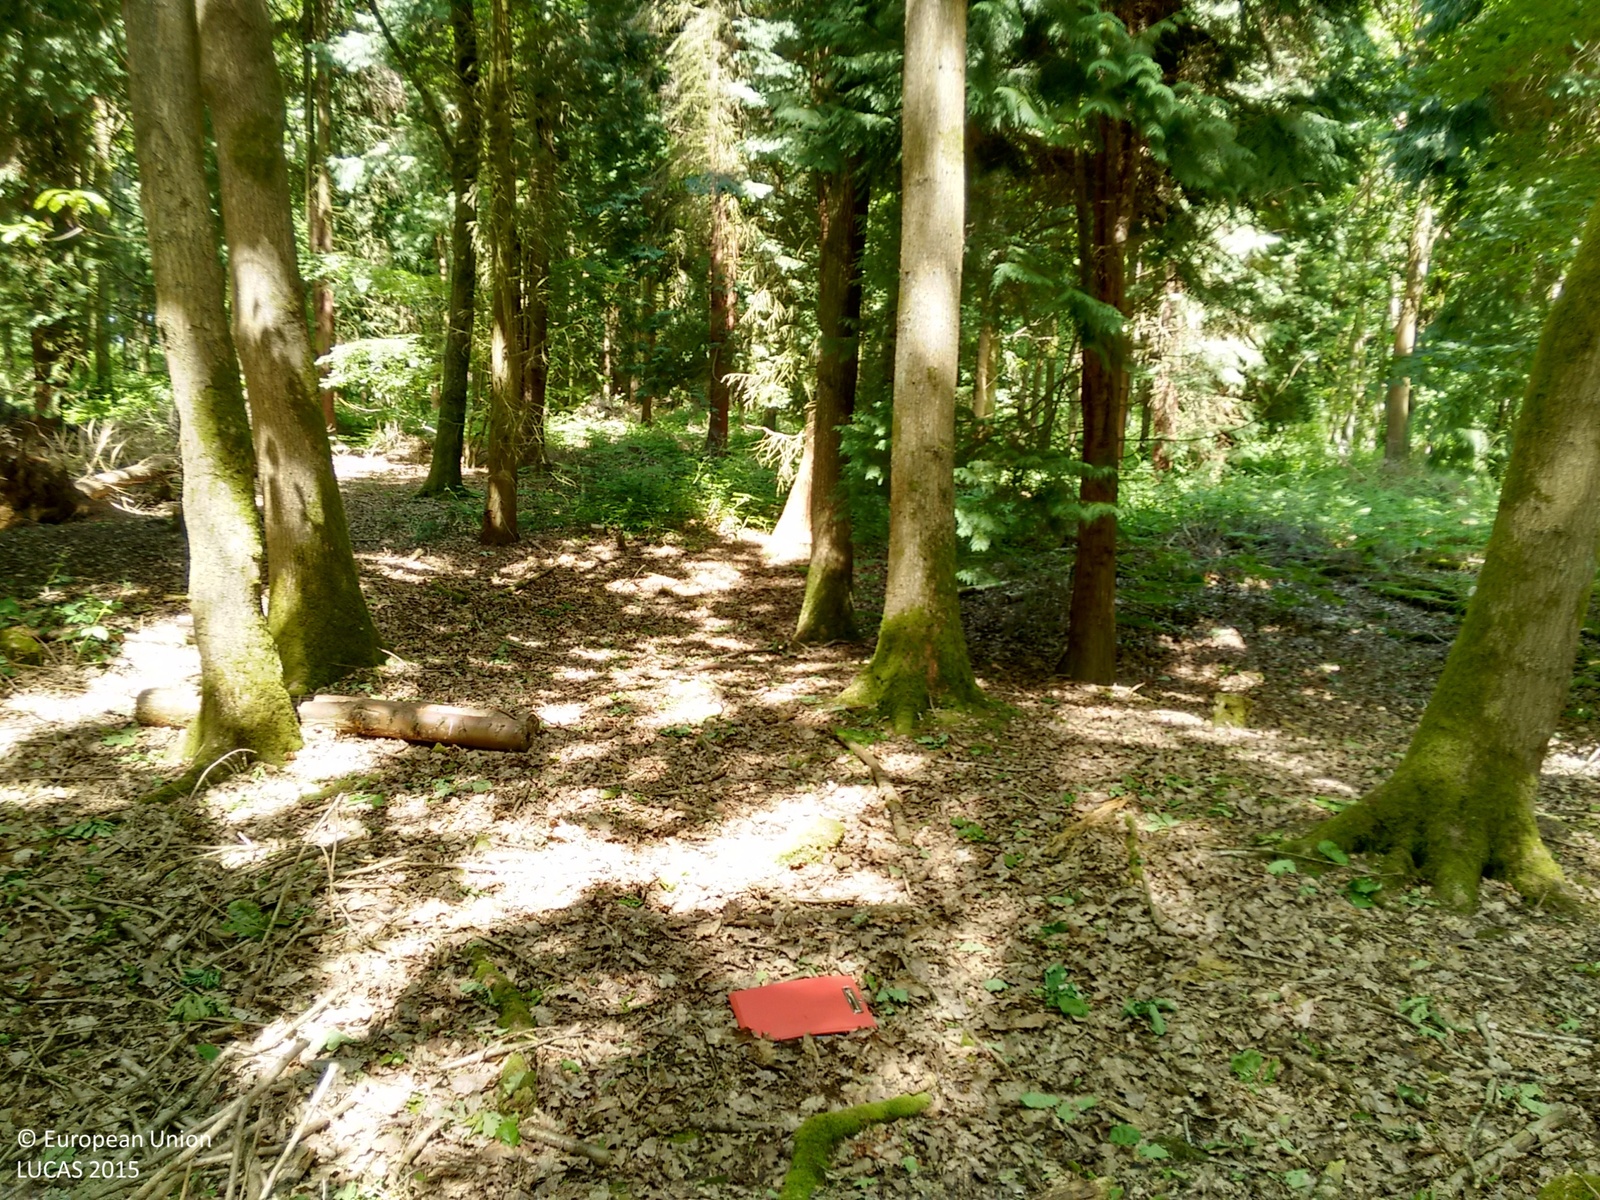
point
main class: Woodland
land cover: Other mixed woodland
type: exotic forest
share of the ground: > 75 %
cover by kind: broadleaved forest trees 50 %, coniferous forest trees 40 %, herbaceous plants 10 %
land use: Forestry
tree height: > 5 m
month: June
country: GB
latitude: 51.8379
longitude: -0.2969
